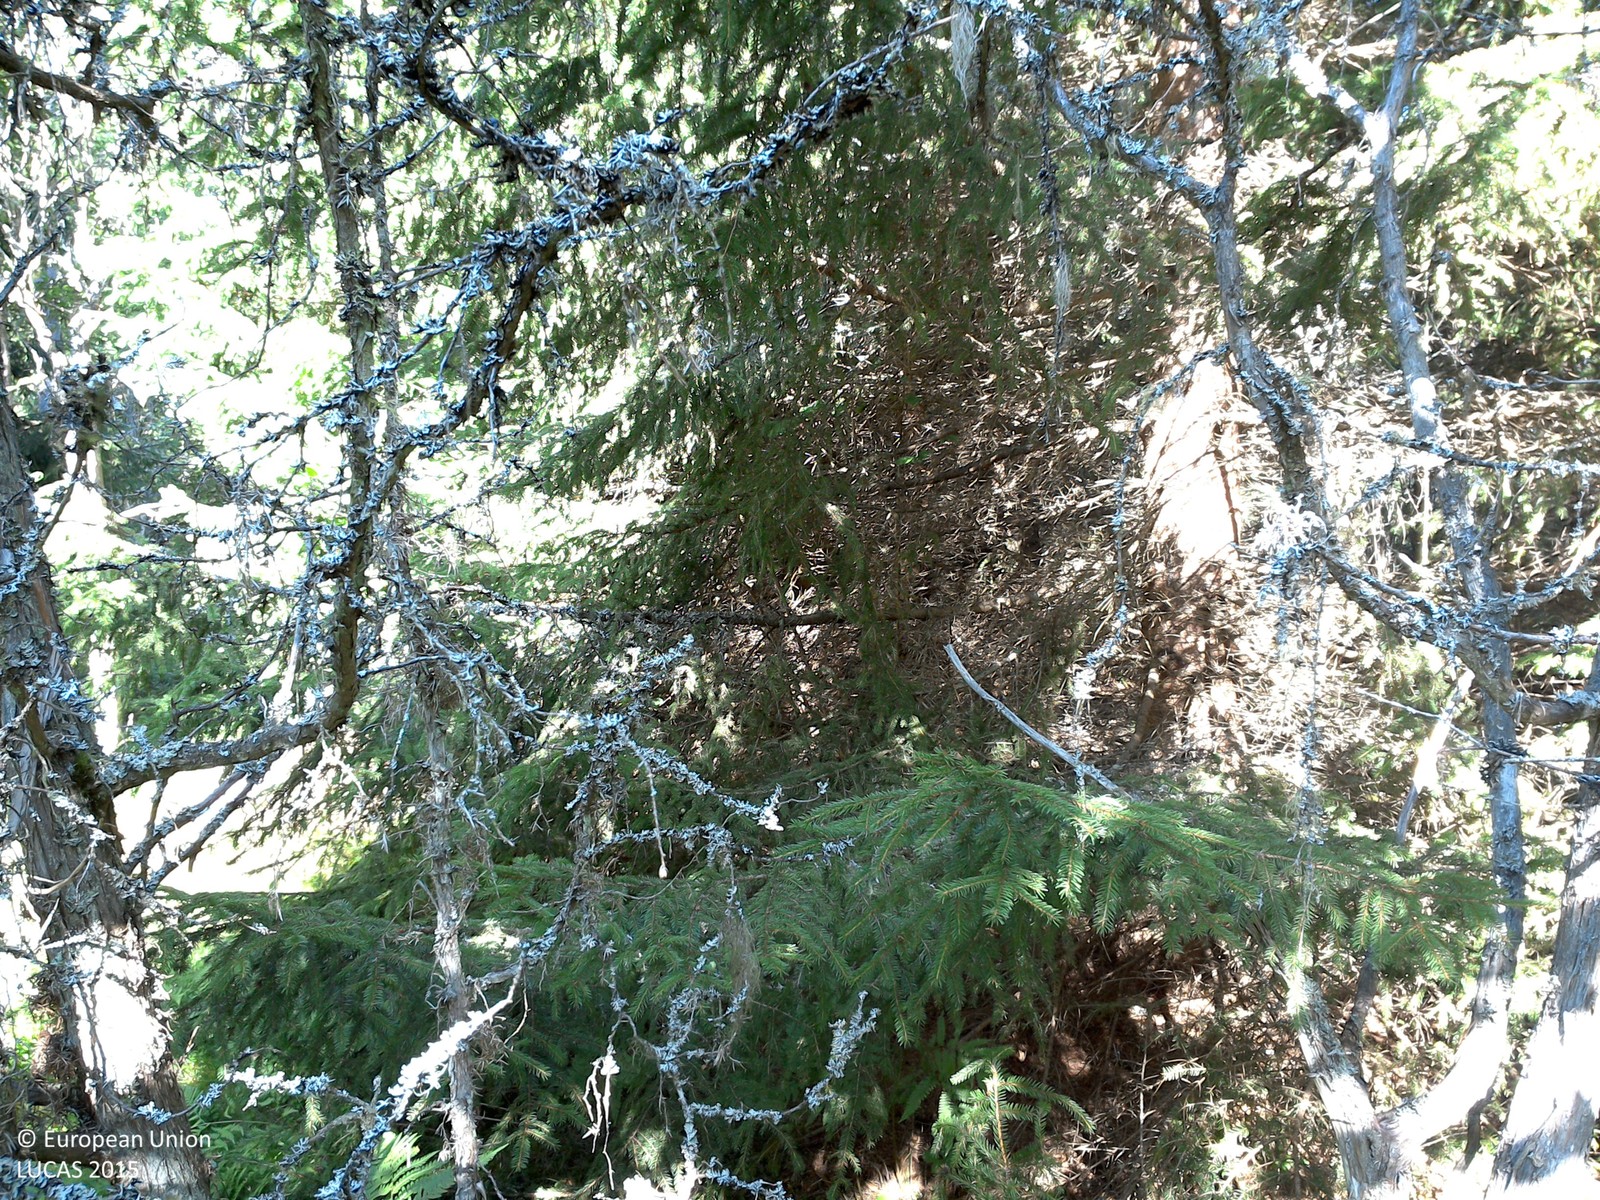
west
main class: Woodland
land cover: Spruce dominated mixed woodland
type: boreal forest
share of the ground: 50 - 75 %
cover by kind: coniferous forest trees 50 %, herbaceous plants 30 %, broadleaved forest trees 20 %
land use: Forestry
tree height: > 5 m
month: August
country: SE
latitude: 58.0906
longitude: 14.9985
